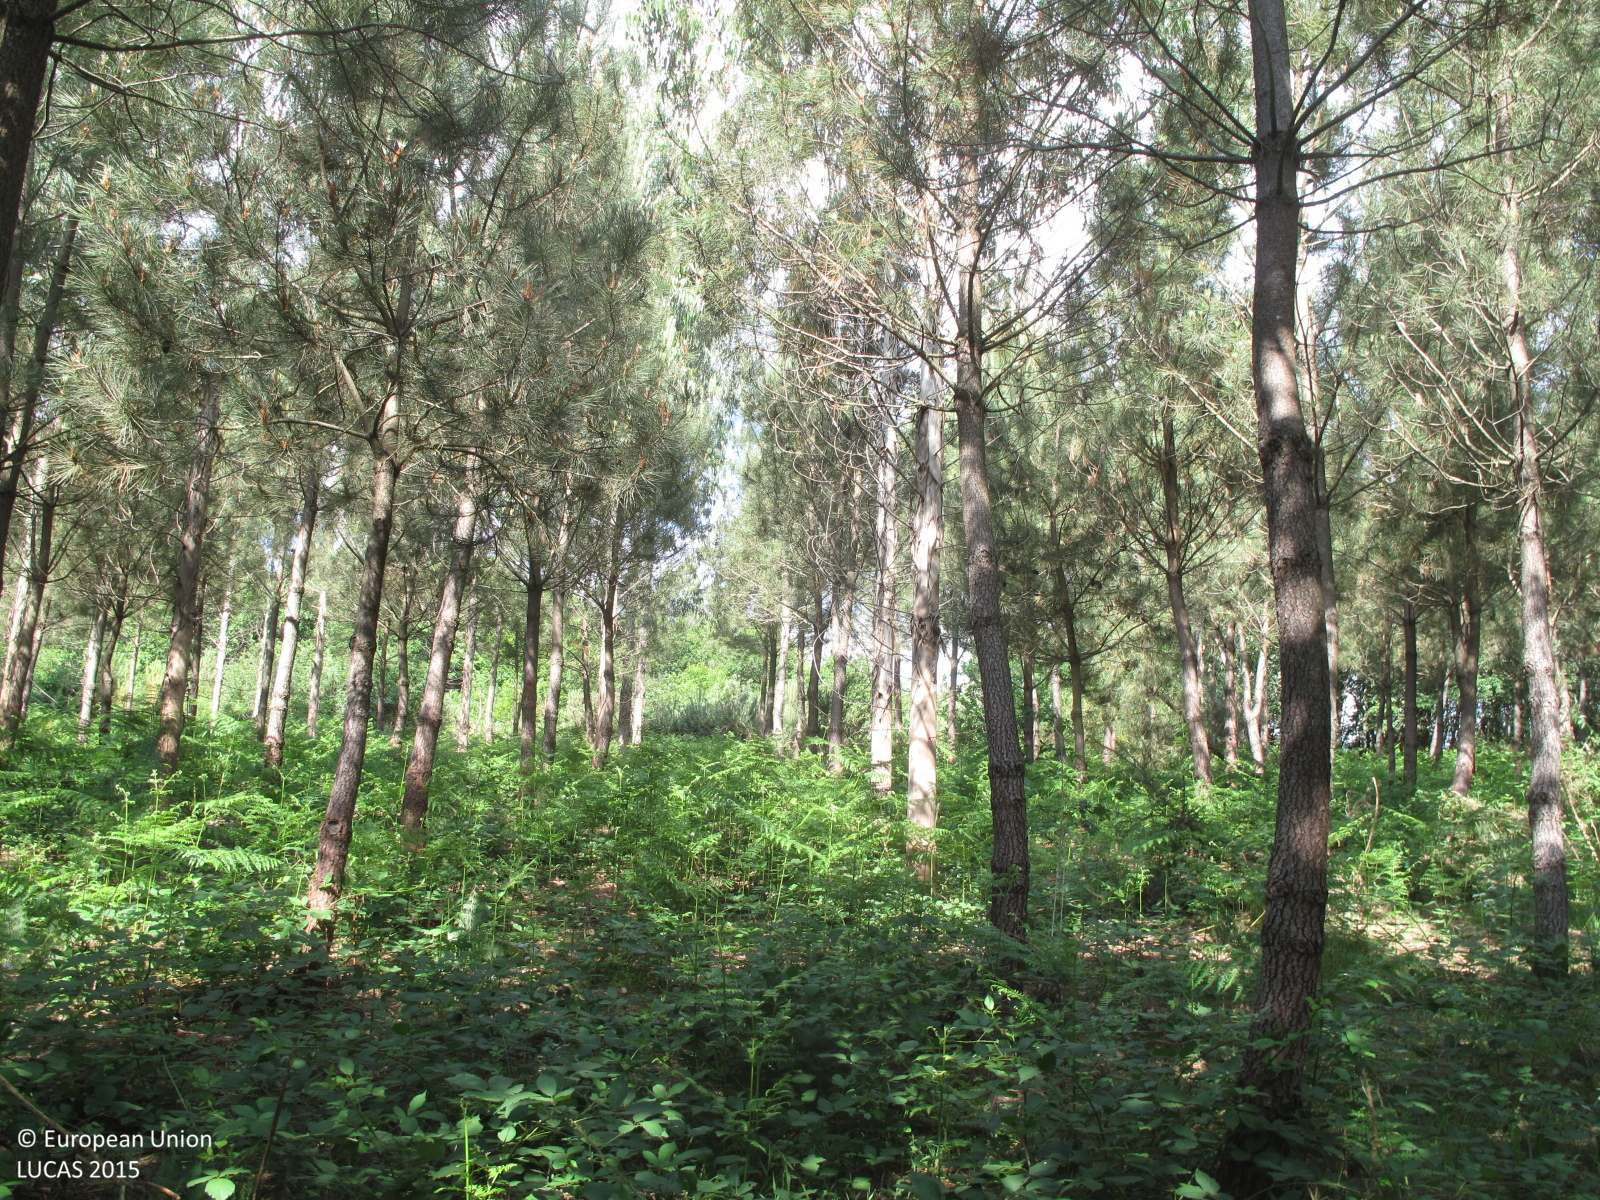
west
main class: Woodland
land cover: Other mixed woodland
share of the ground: > 75 %
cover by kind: coniferous forest trees 50 %, broadleaved forest trees 40 %, shrubs 10 %
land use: Forestry
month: June
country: ES
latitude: 42.9809
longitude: -8.5118
